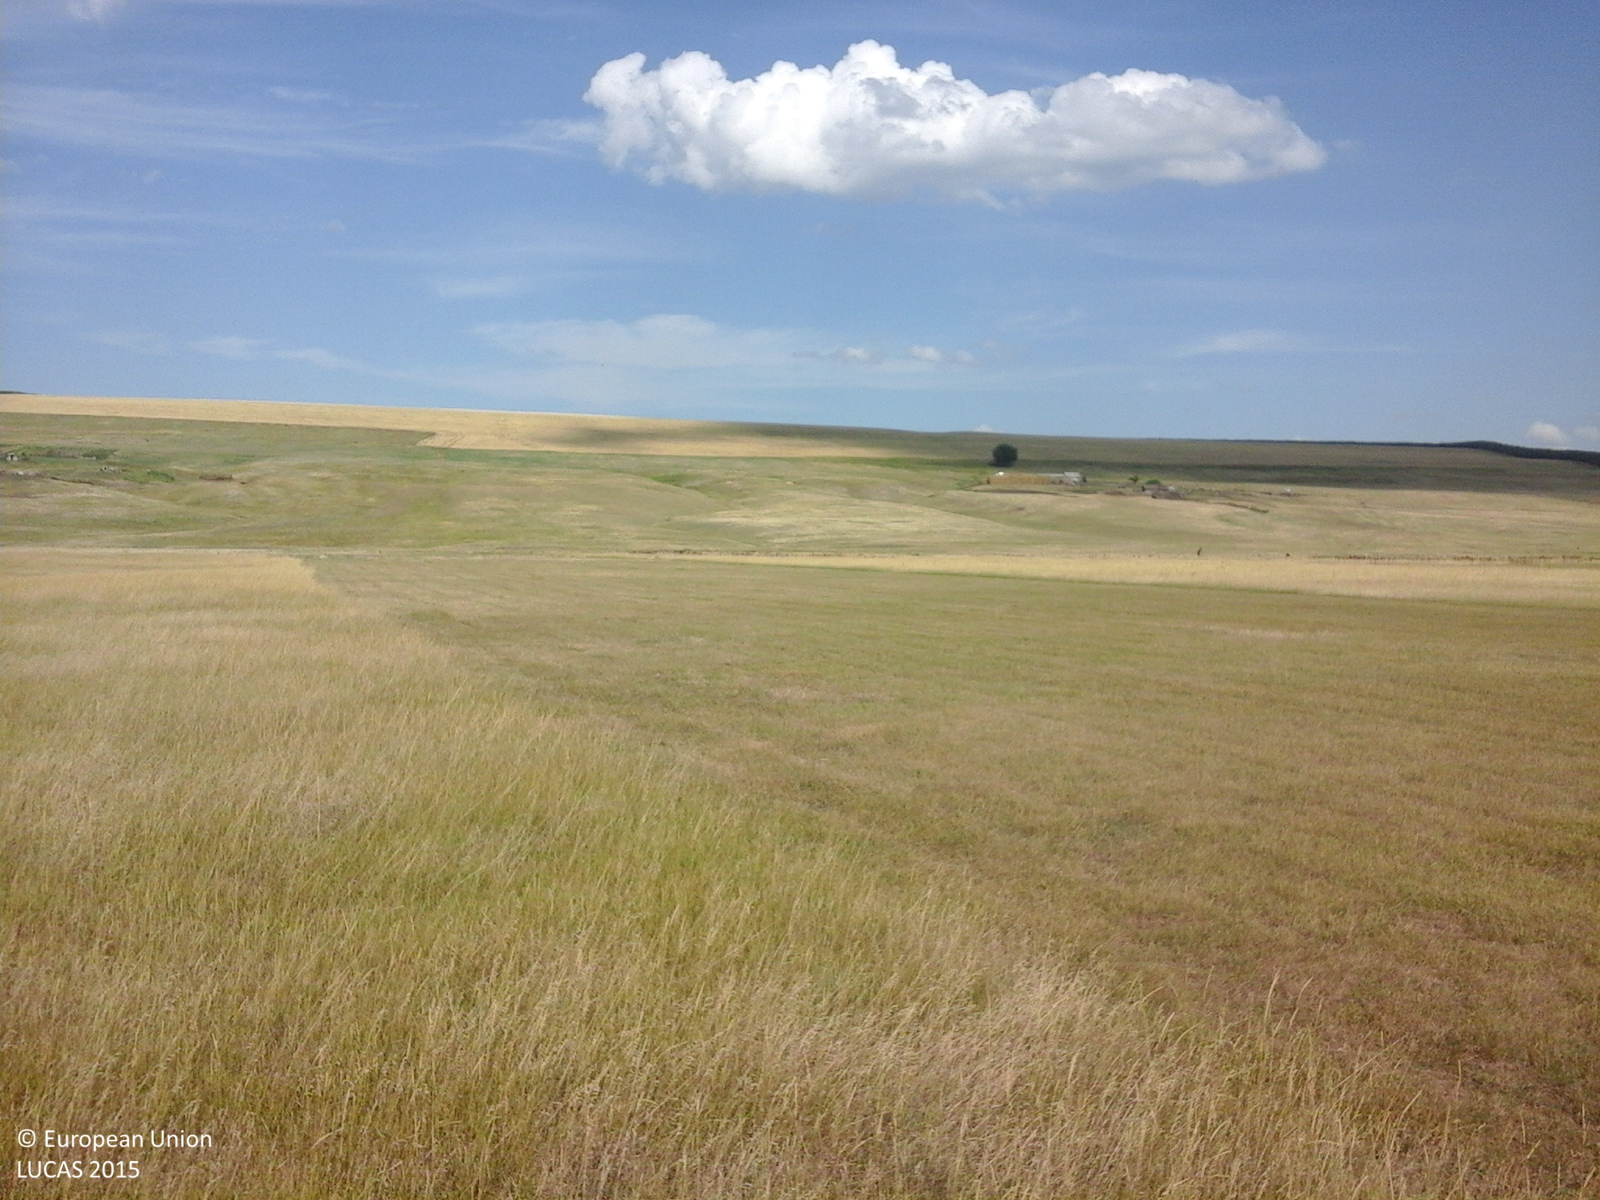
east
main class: Grassland
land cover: Grassland without tree/shrub cover
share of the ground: > 75 %
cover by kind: herbaceous plants 100 %
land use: Agriculture (excluding fallow land and kitchen gardens)
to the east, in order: Grassland without tree/shrub cover; Ditches and canals; Grassland without tree/shrub cover
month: July
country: RO
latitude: 46.5009
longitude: 28.1256
